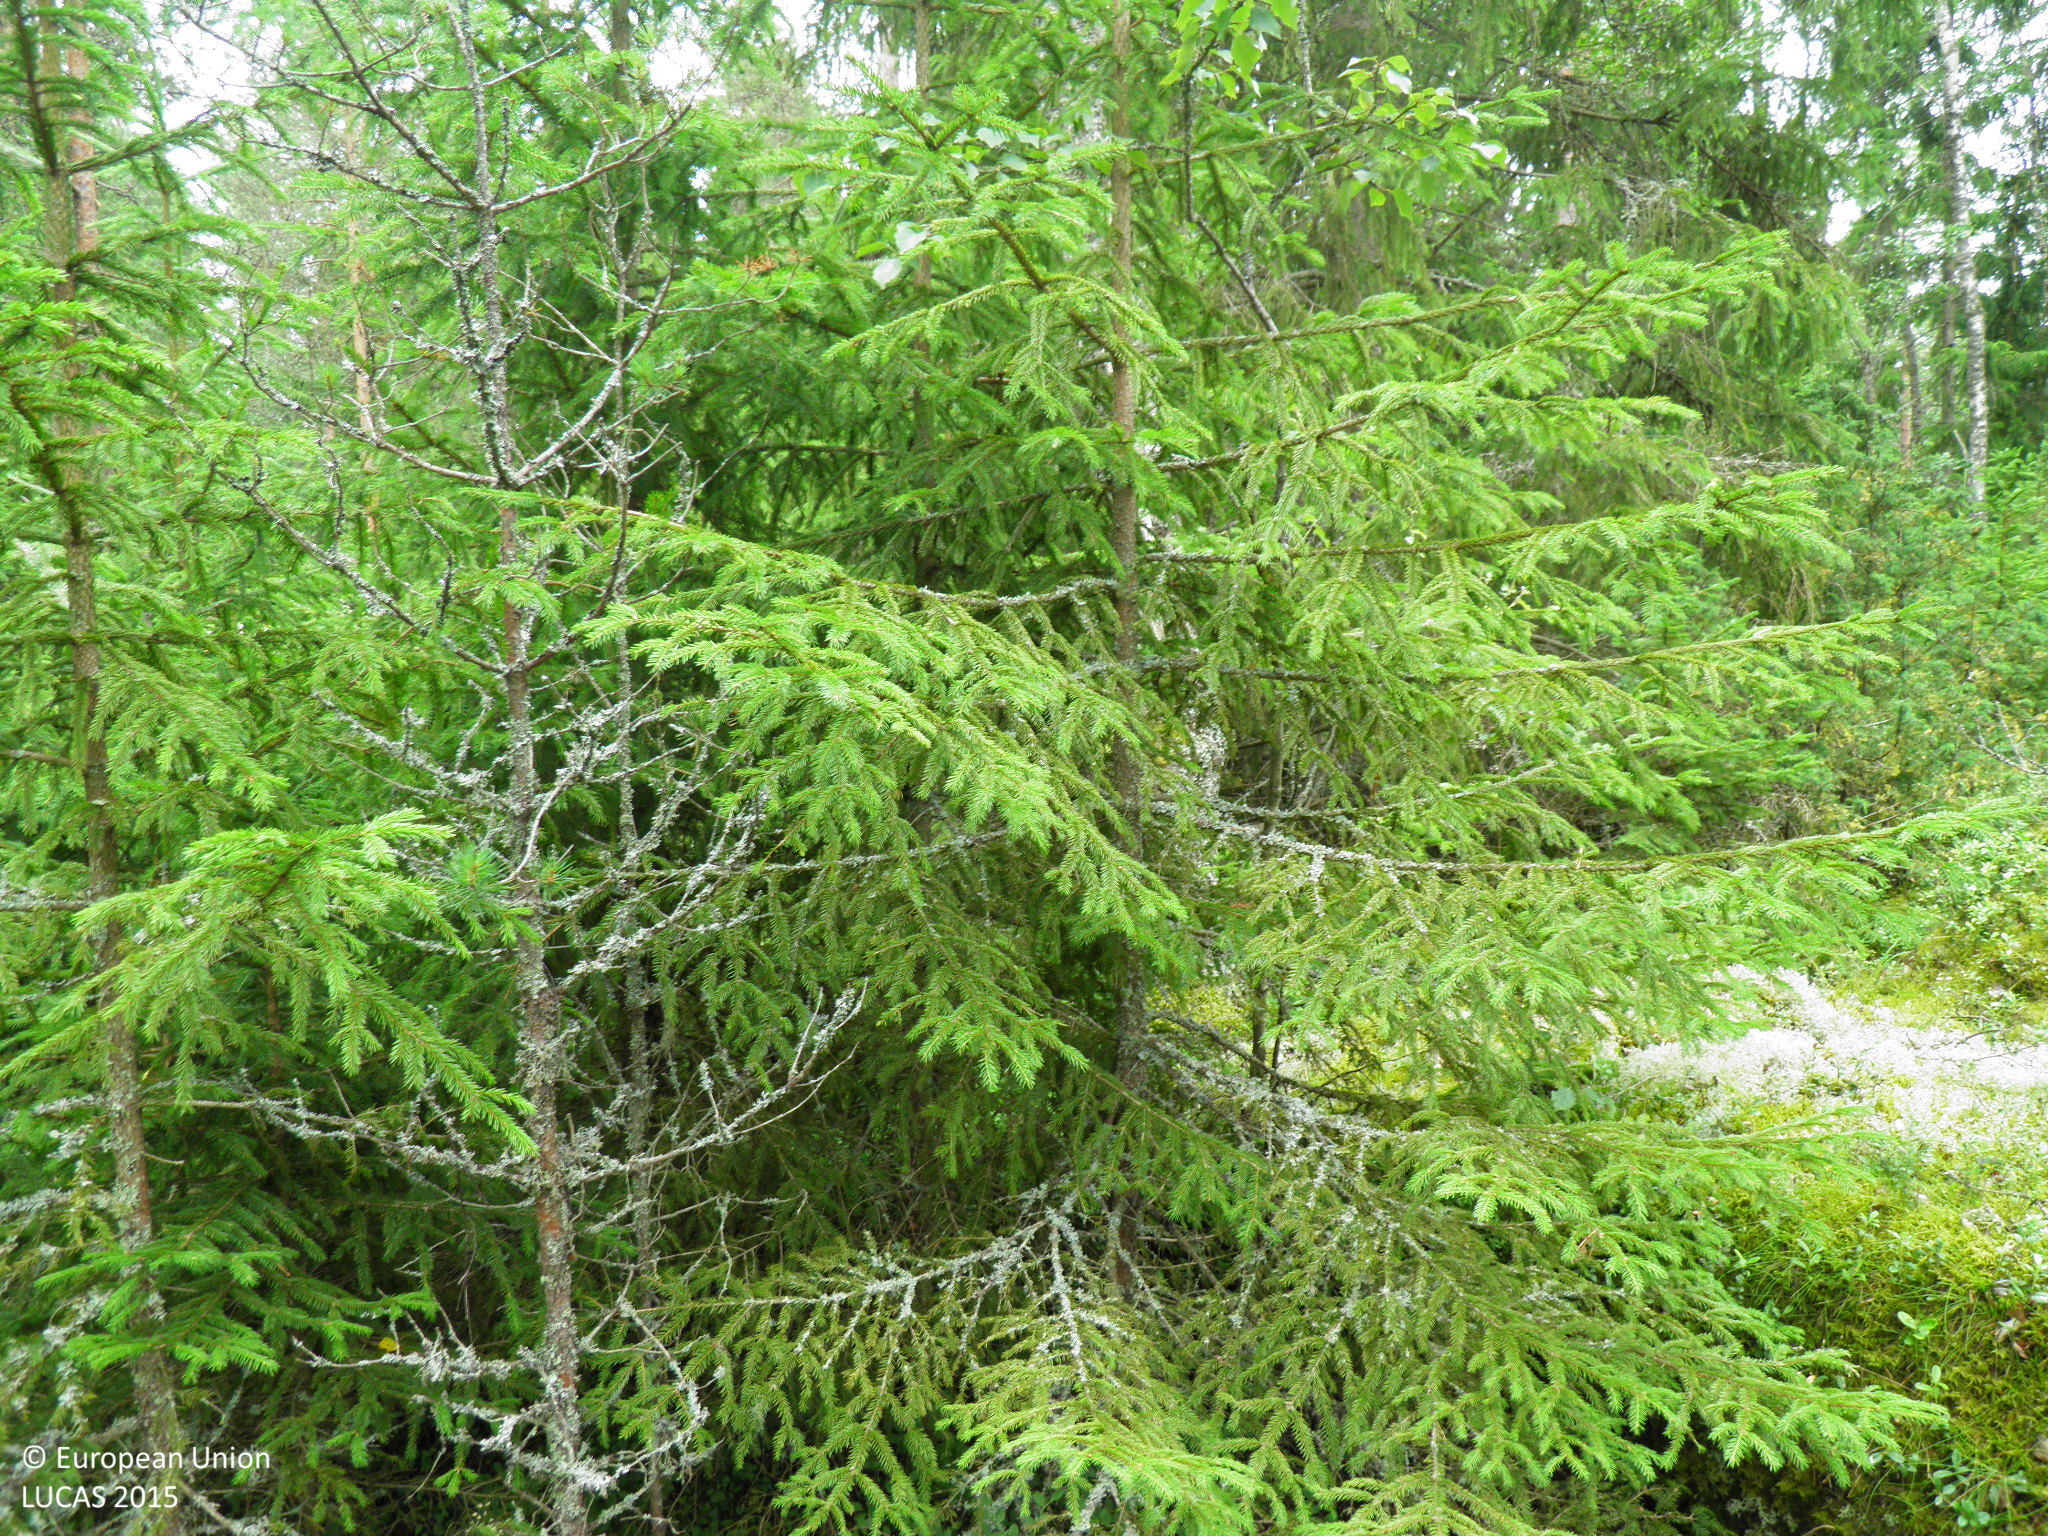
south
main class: Woodland
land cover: Other coniferous woodland
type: hemiboreal forest and nemoral coniferous forest and mixed broadleaved-coniferous forest
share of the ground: 25 - 50 %
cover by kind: lichens and mosses 50 %, coniferous forest trees 30 %, broadleaved forest trees 10 %, shrubs 10 %
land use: Forestry
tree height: > 5 m
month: July
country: FI
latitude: 60.6099
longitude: 21.6208
